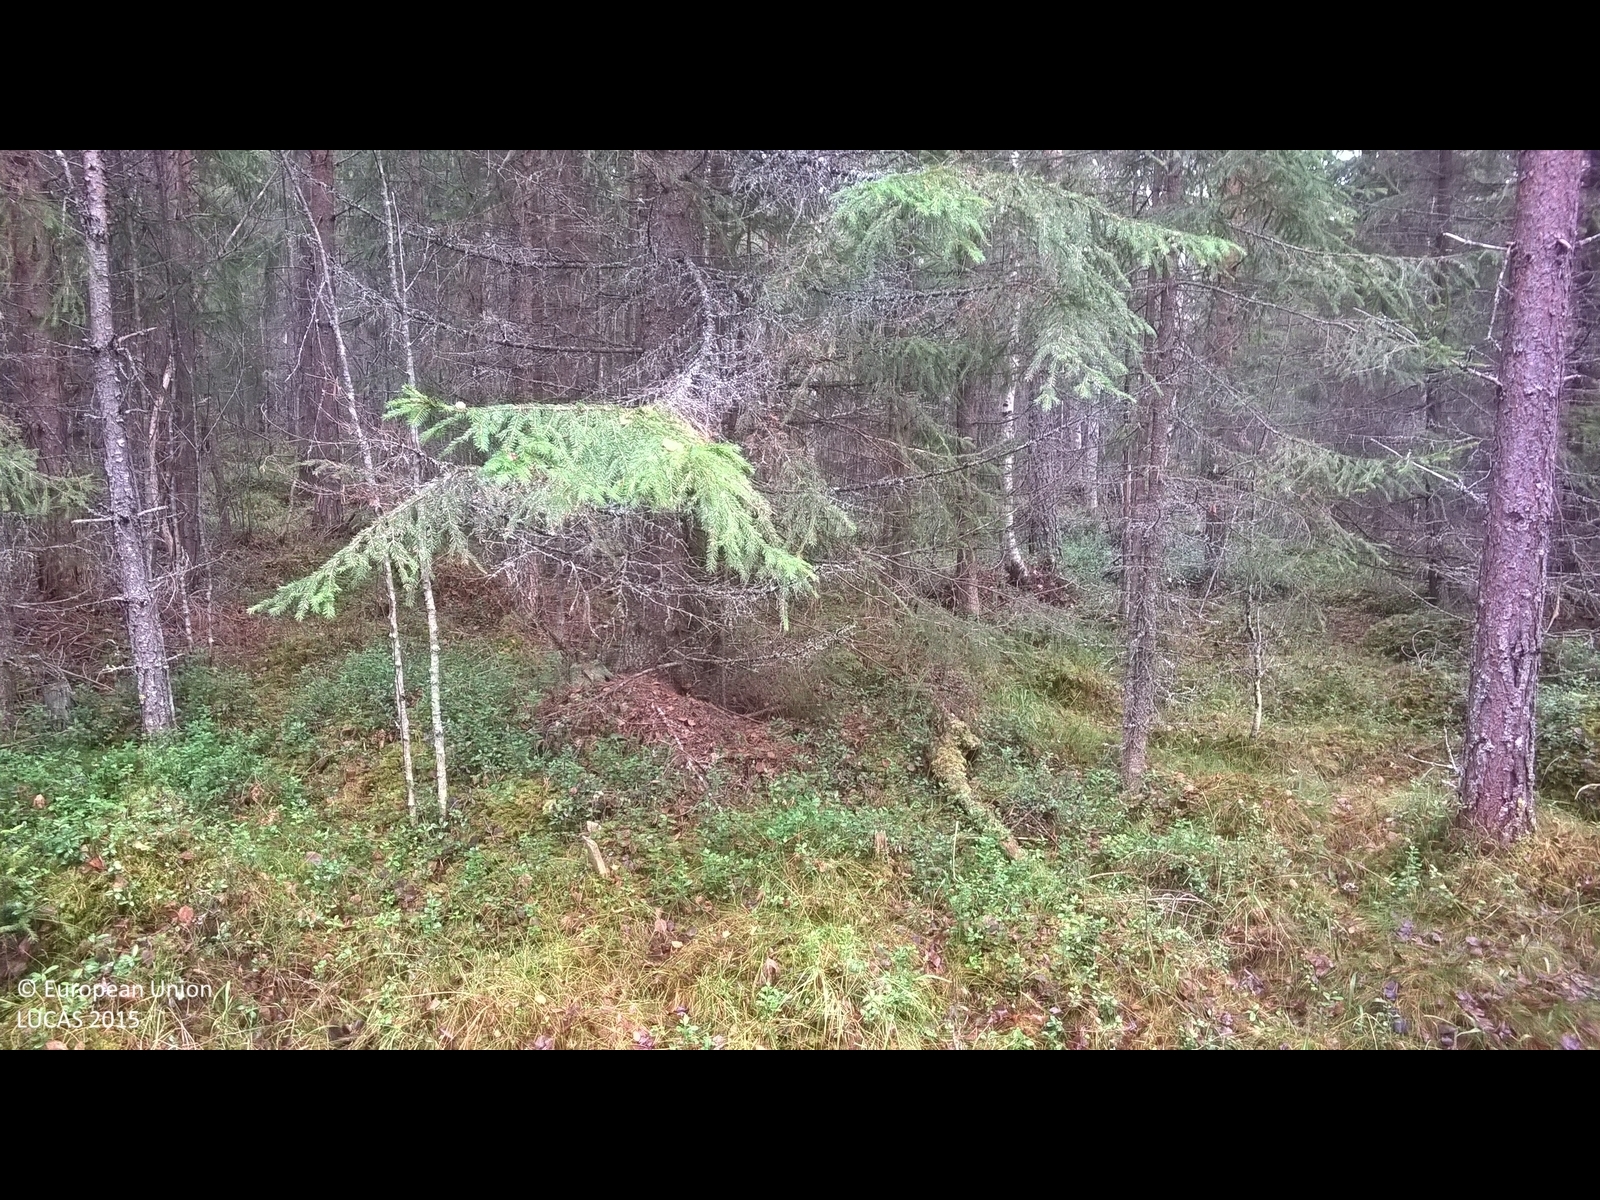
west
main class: Woodland
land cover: Spruce dominated mixed woodland
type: boreal forest
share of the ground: > 75 %
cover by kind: coniferous forest trees 60 %, broadleaved forest trees 30 %, herbaceous plants 5 %, lichens and mosses 5 %
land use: Forestry
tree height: > 5 m
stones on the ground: < 10 %
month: November
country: SE
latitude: 62.8871
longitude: 15.6225
